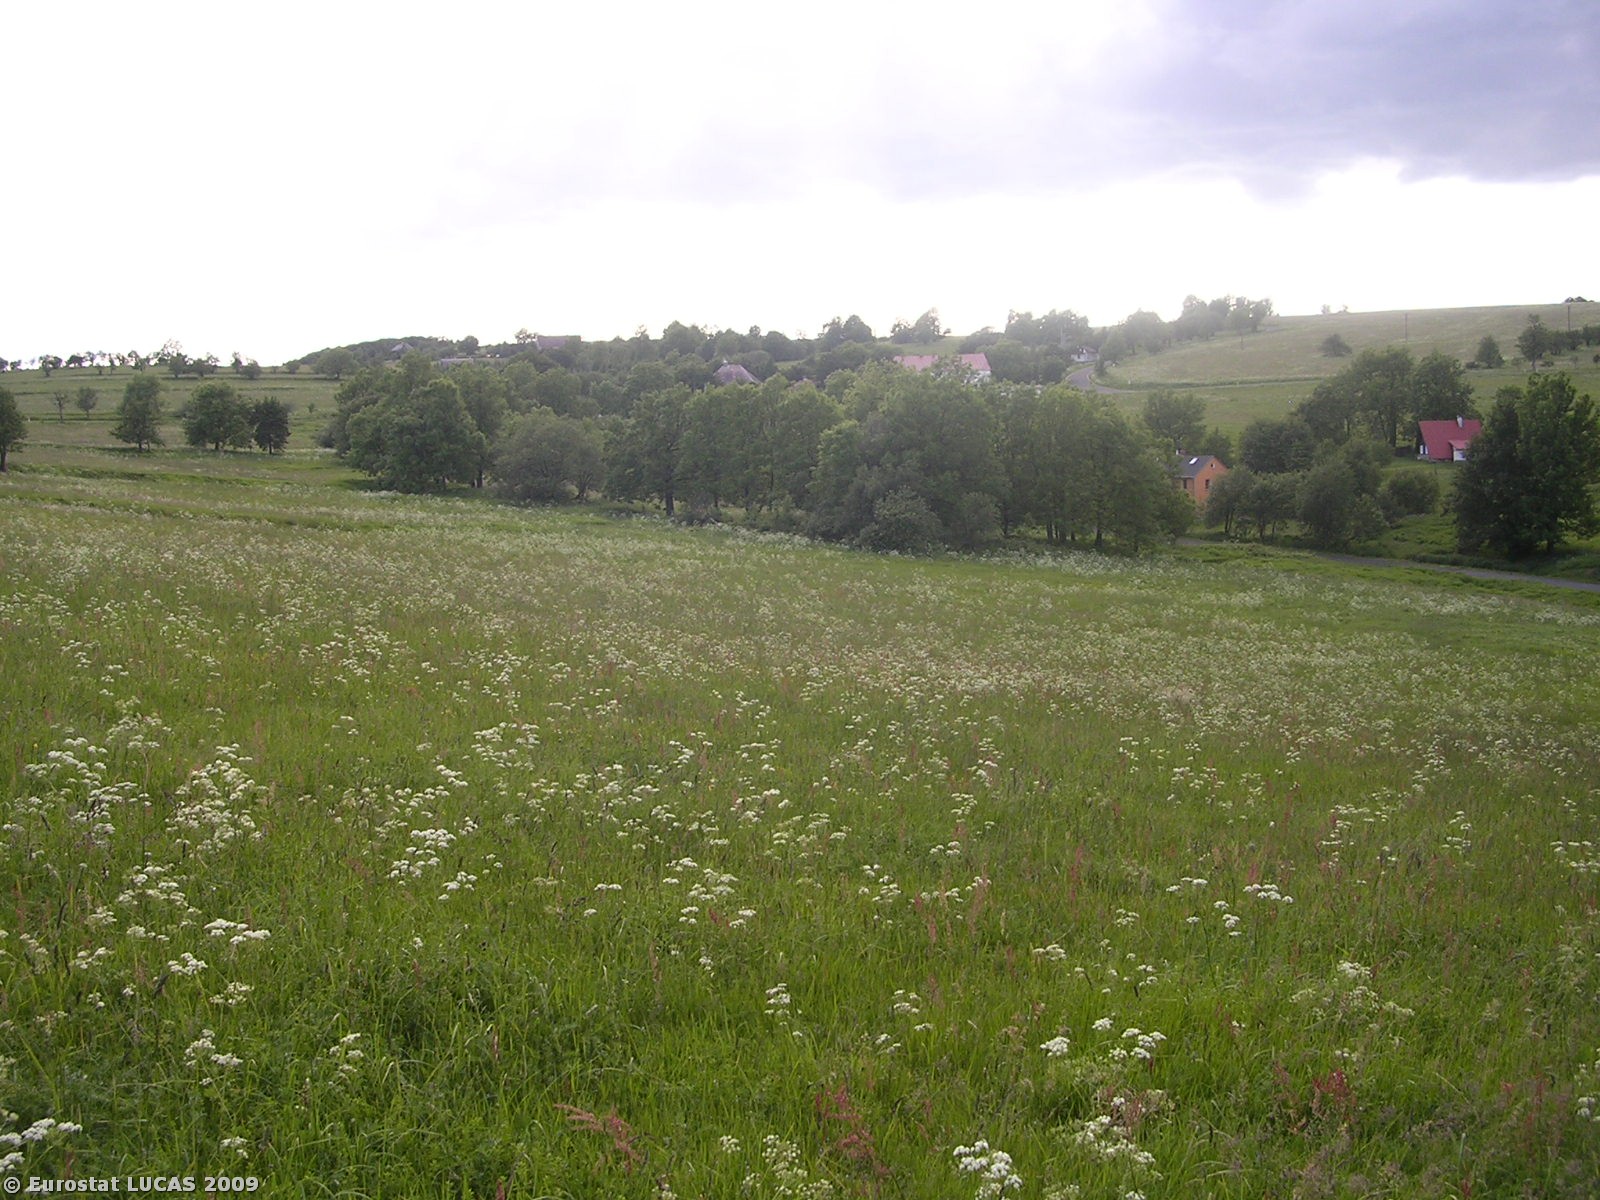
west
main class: Grassland
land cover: Grassland without tree/shrub cover
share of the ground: > 75 %
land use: Agriculture (excluding fallow land and kitchen gardens)
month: June
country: CZ
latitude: 50.7448
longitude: 13.9833
